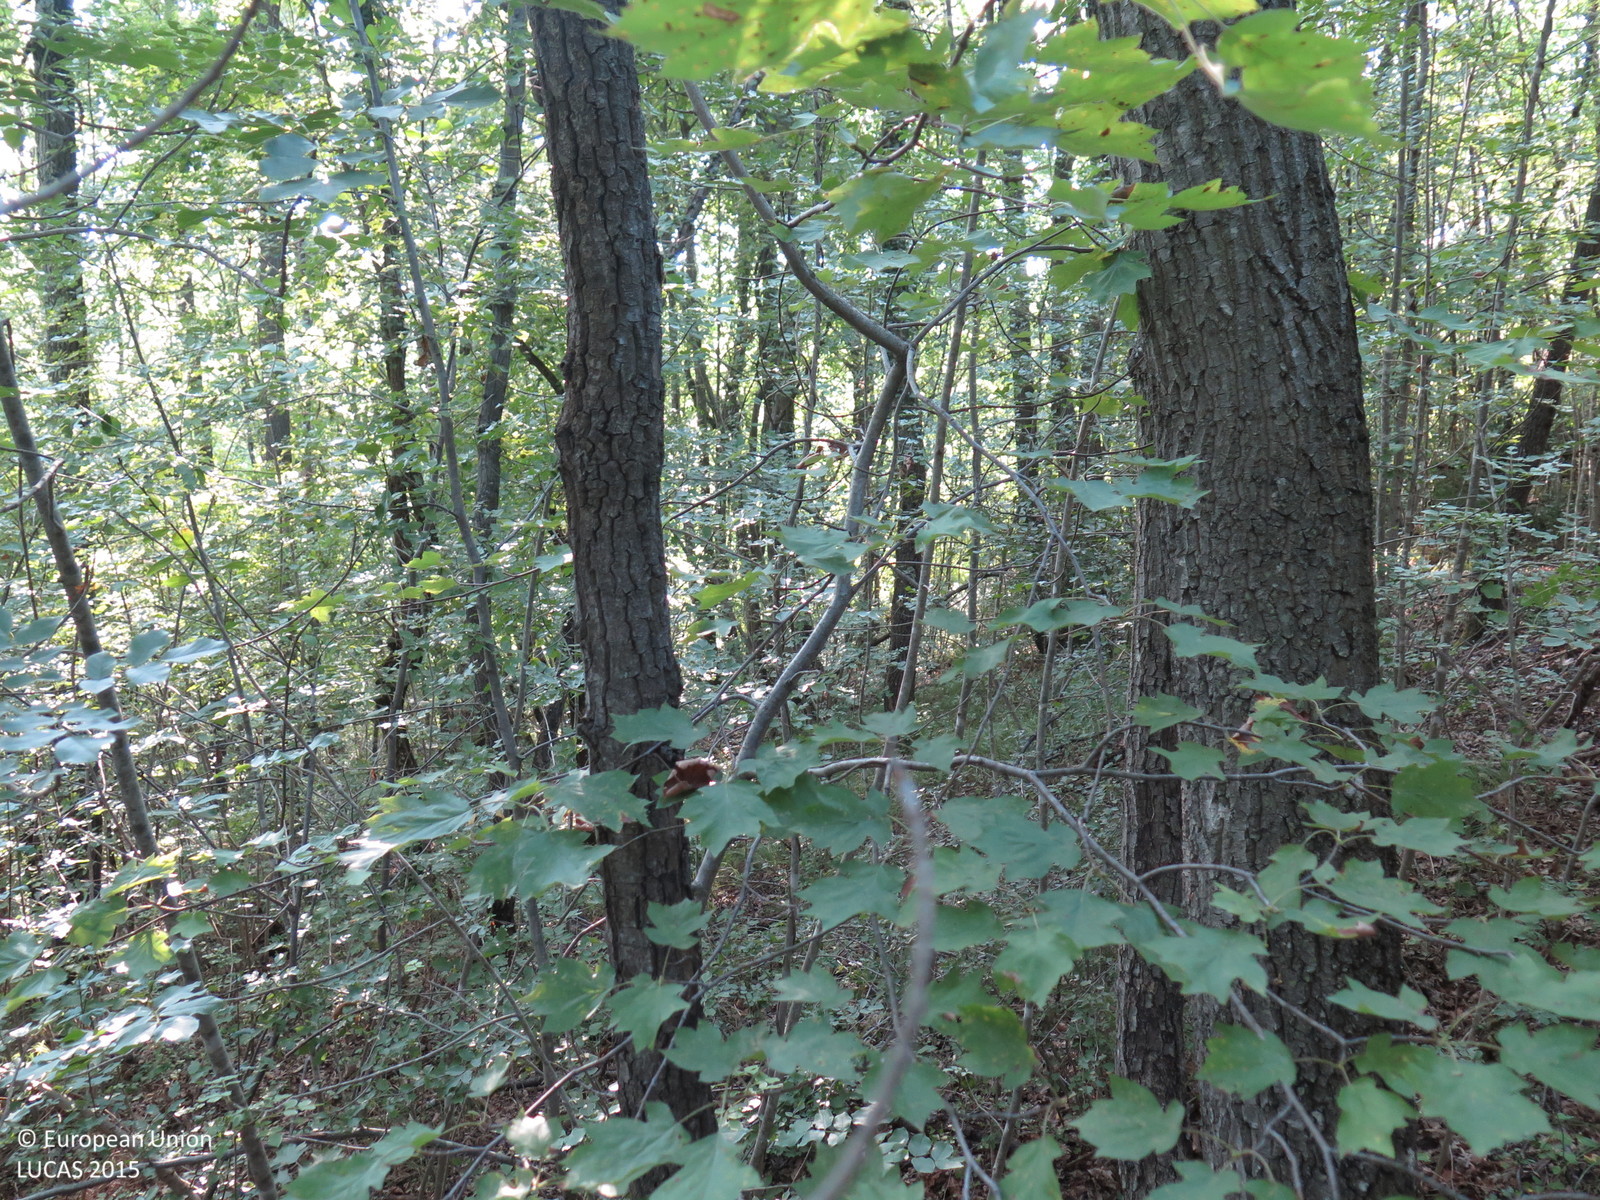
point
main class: Woodland
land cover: Broadleaved woodland
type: acidophilous oak and oak-birch forest
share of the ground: > 75 %
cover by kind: broadleaved forest trees 90 %, shrubs 5 %, herbaceous plants 5 %
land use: Semi-natural and natural areas not in use
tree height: > 5 m
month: August
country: HR
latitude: 45.3179
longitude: 14.0643
